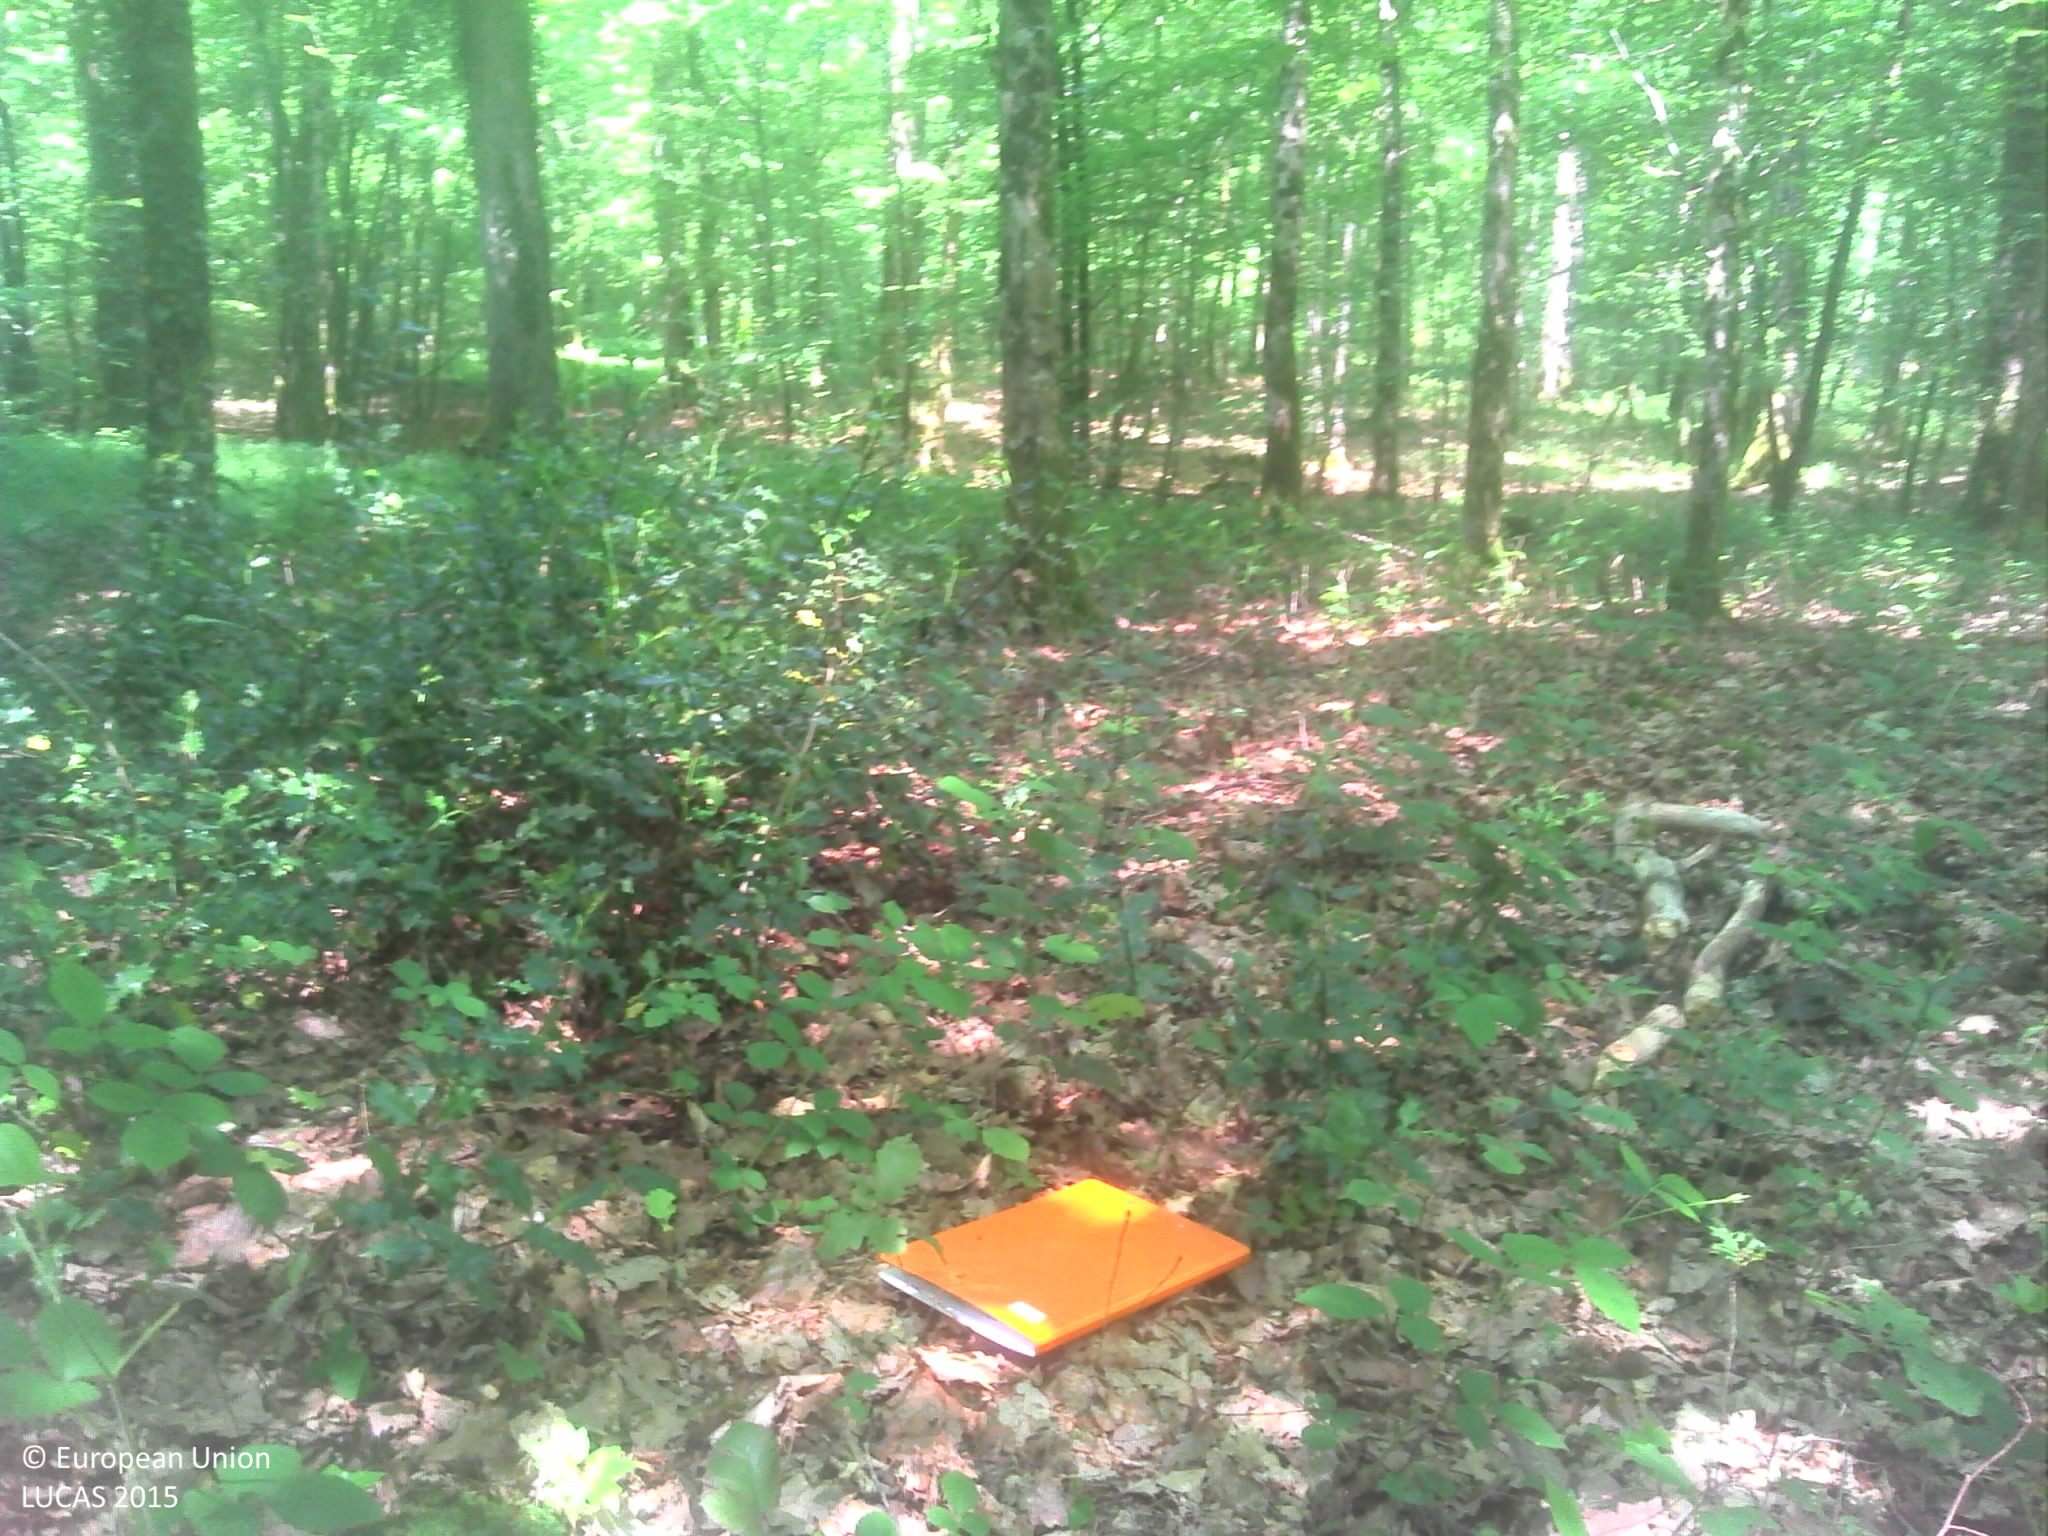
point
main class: Woodland
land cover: Broadleaved woodland
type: beech forest
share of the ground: > 75 %
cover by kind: broadleaved forest trees 90 %, herbaceous plants 10 %
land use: Forestry
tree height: > 5 m
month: June
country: FR
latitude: 48.4649
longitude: 4.8724
